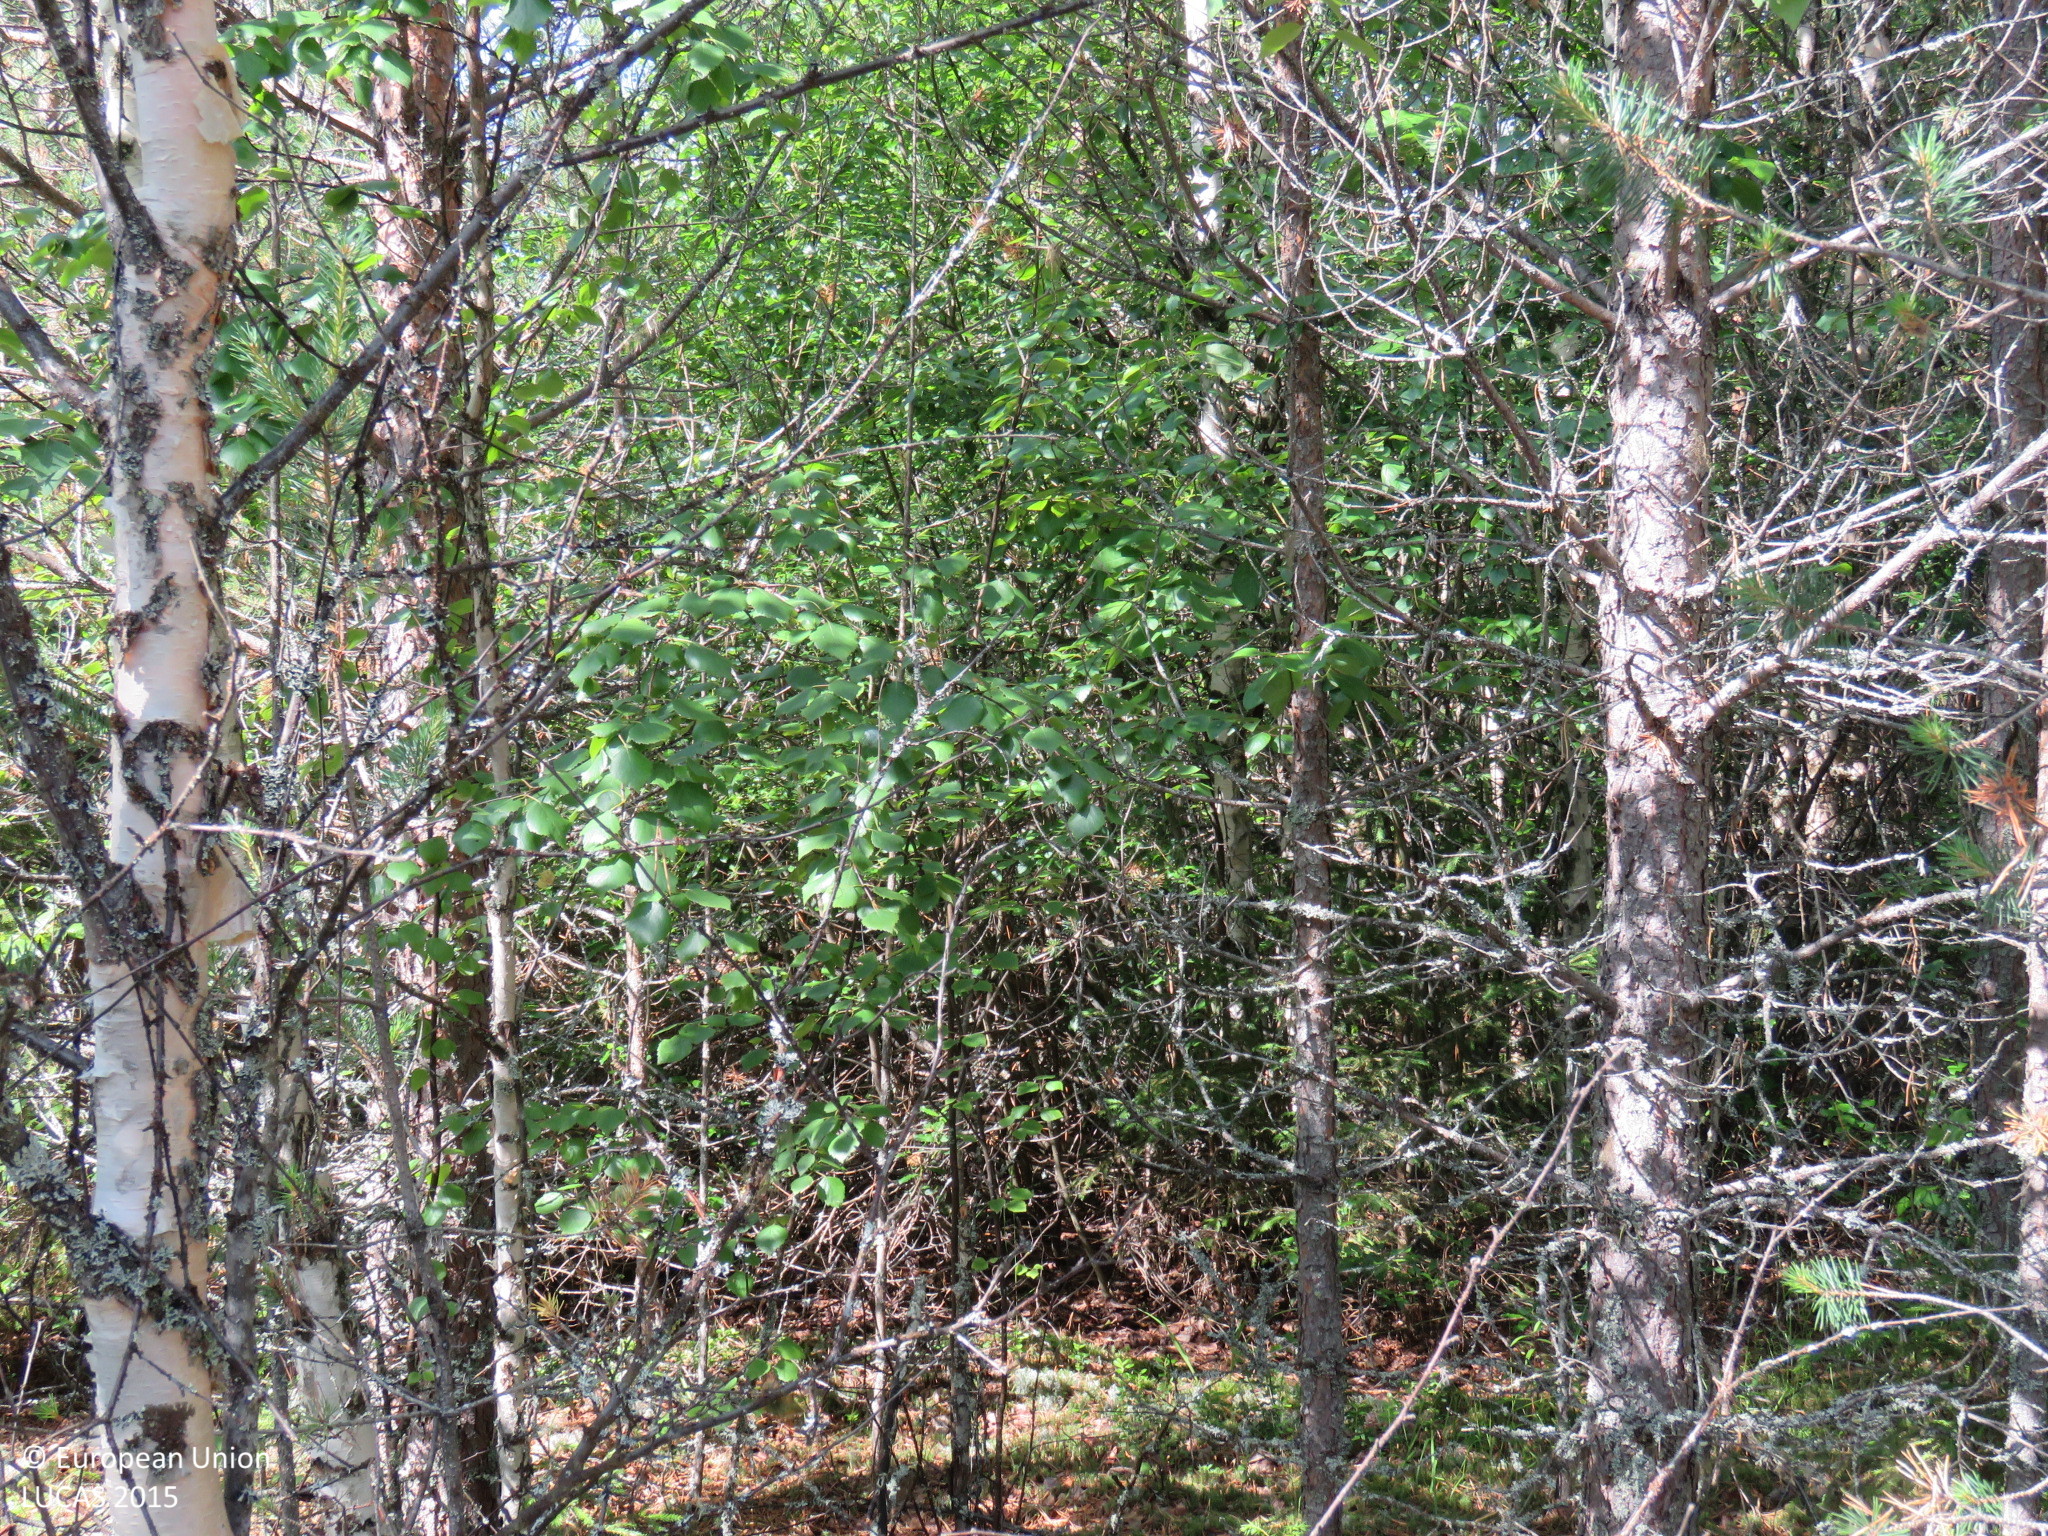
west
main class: Woodland
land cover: Other mixed woodland
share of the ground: > 75 %
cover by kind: coniferous forest trees 50 %, broadleaved forest trees 45 %, lichens and mosses 5 %
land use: Road transport
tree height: > 5 m
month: July
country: FI
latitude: 64.5648
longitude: 26.6664
